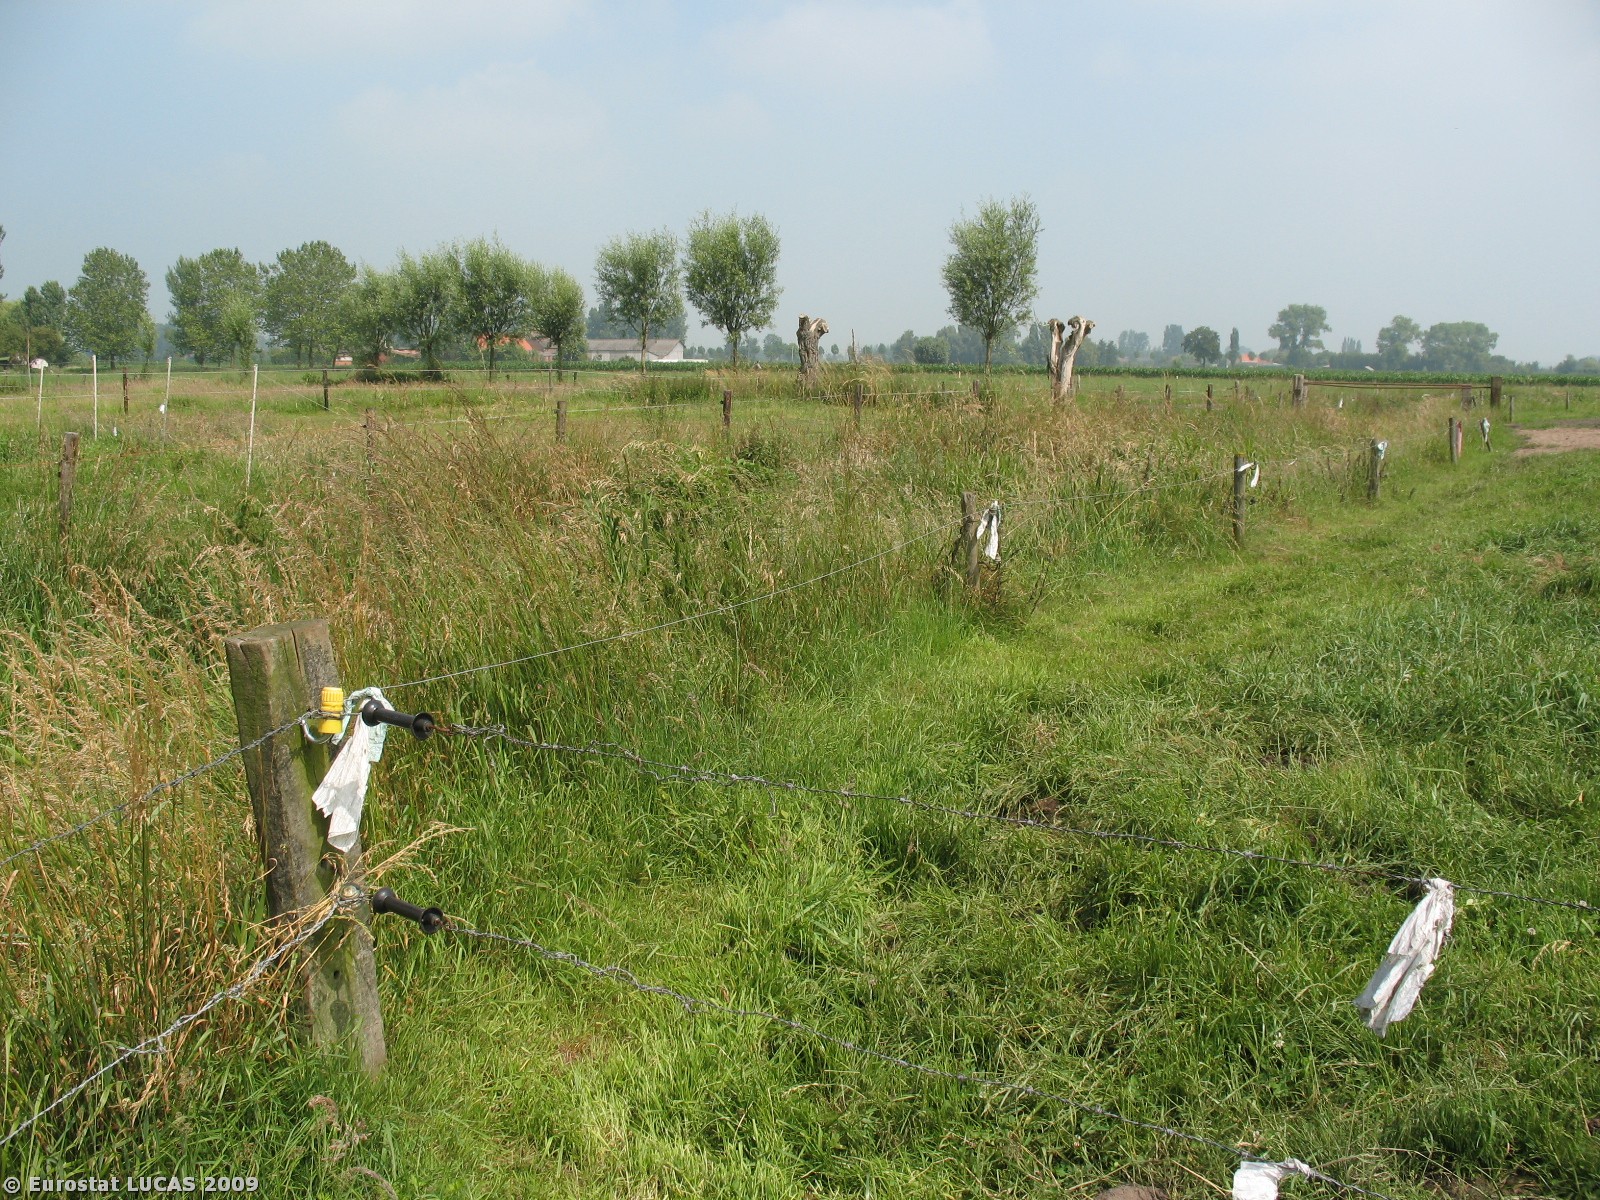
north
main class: Grassland
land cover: Grassland without tree/shrub cover
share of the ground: > 75 %
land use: Agriculture (excluding fallow land and kitchen gardens)
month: June
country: BE
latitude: 51.2188
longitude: 3.7077
